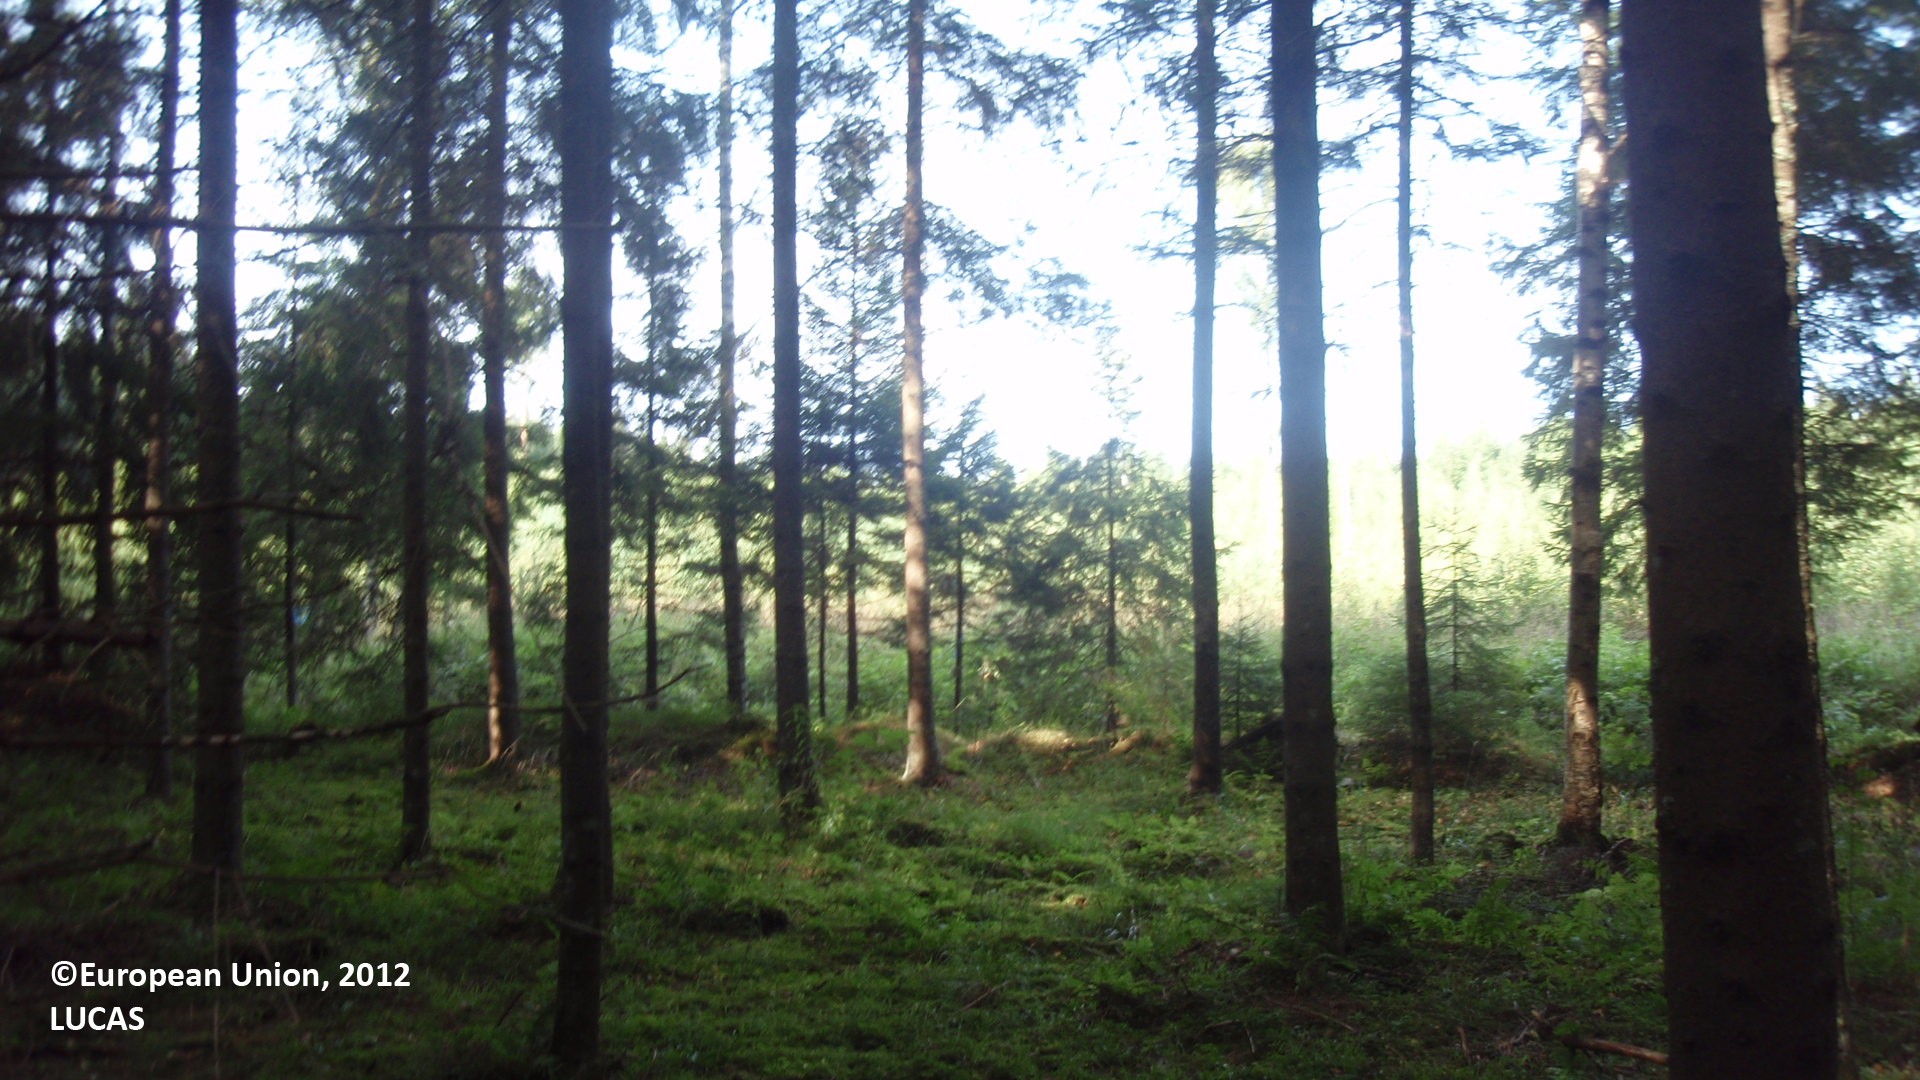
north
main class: Woodland
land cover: Spruce dominated coniferous woodland
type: boreal forest
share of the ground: 50 - 75 %
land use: Forestry
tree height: > 5 m
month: August
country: FI
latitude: 60.7726
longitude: 27.2320
